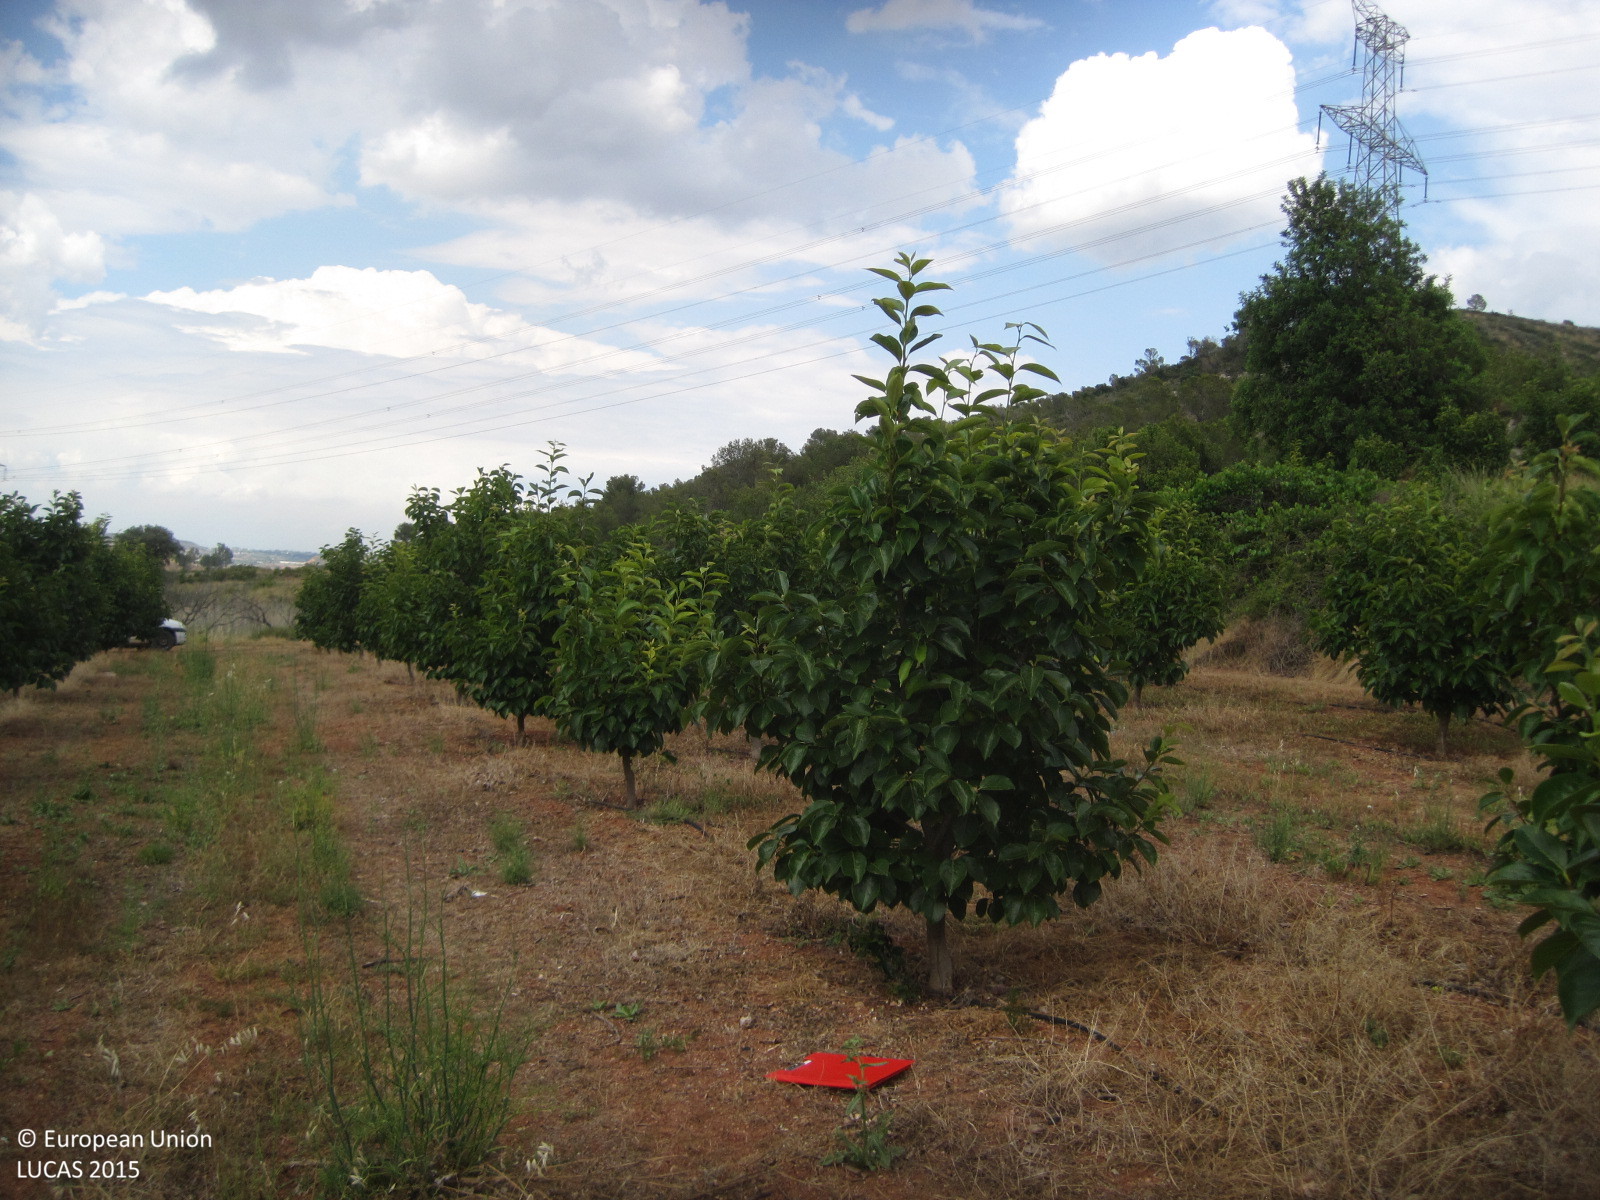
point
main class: Cropland
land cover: Other fruit trees and berries
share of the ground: 25 - 50 %
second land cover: Spontaneously vegetated surfaces
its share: > 75 %
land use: Agriculture (excluding fallow land and kitchen gardens)
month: June
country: ES
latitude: 39.2871
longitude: -0.6279
